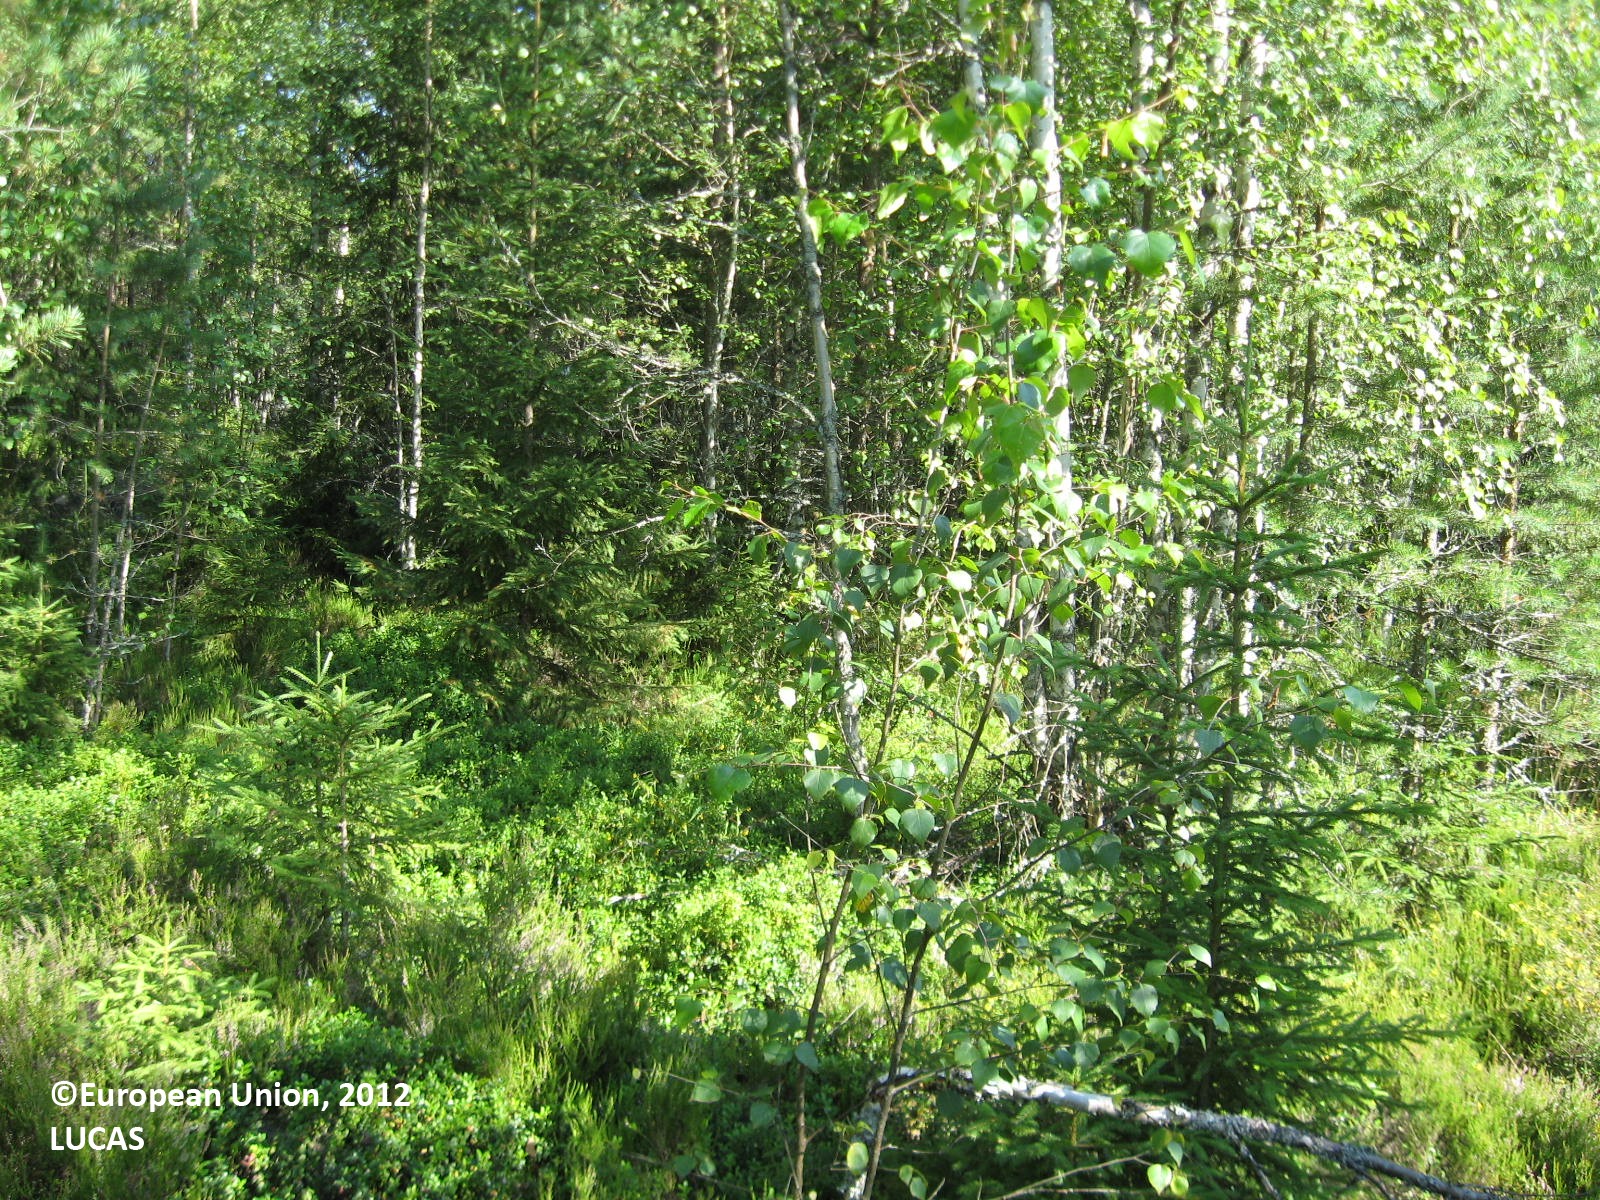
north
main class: Woodland
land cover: Other mixed woodland
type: boreal forest
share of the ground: > 75 %
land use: Forestry
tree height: > 5 m
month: July
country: FI
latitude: 61.8652
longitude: 22.5509
